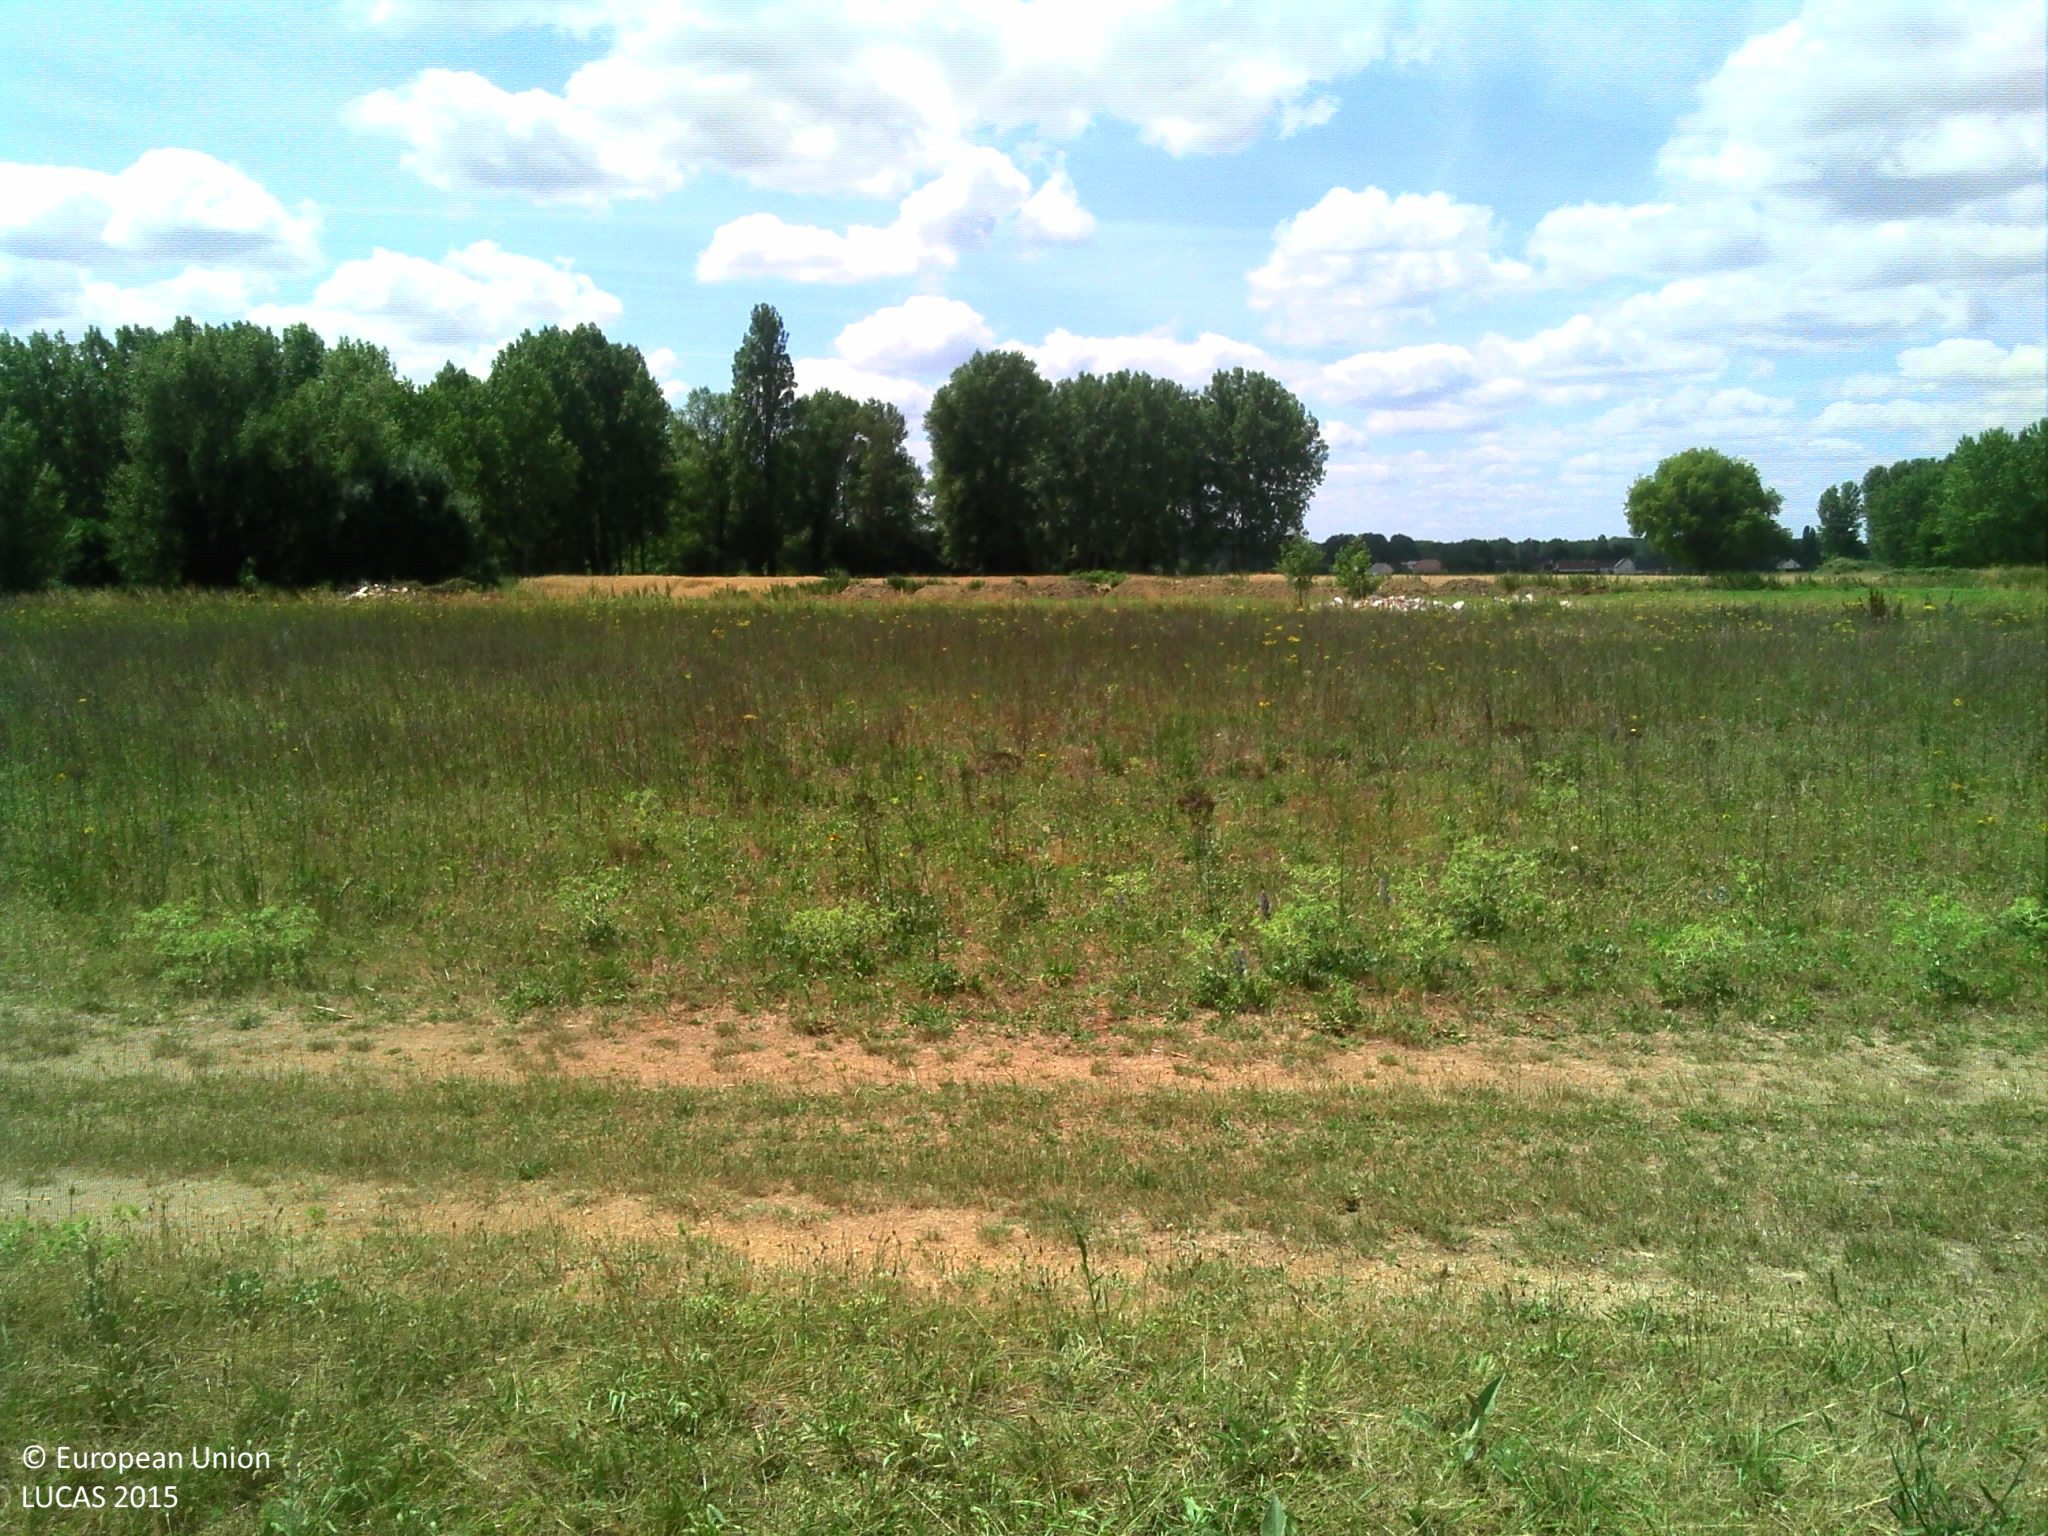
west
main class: Grassland
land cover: Grassland without tree/shrub cover
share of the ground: > 75 %
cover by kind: herbaceous plants 100 %
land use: Agriculture (excluding fallow land and kitchen gardens)
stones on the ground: < 10 %
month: June
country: FR
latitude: 47.4334
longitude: 0.3117
